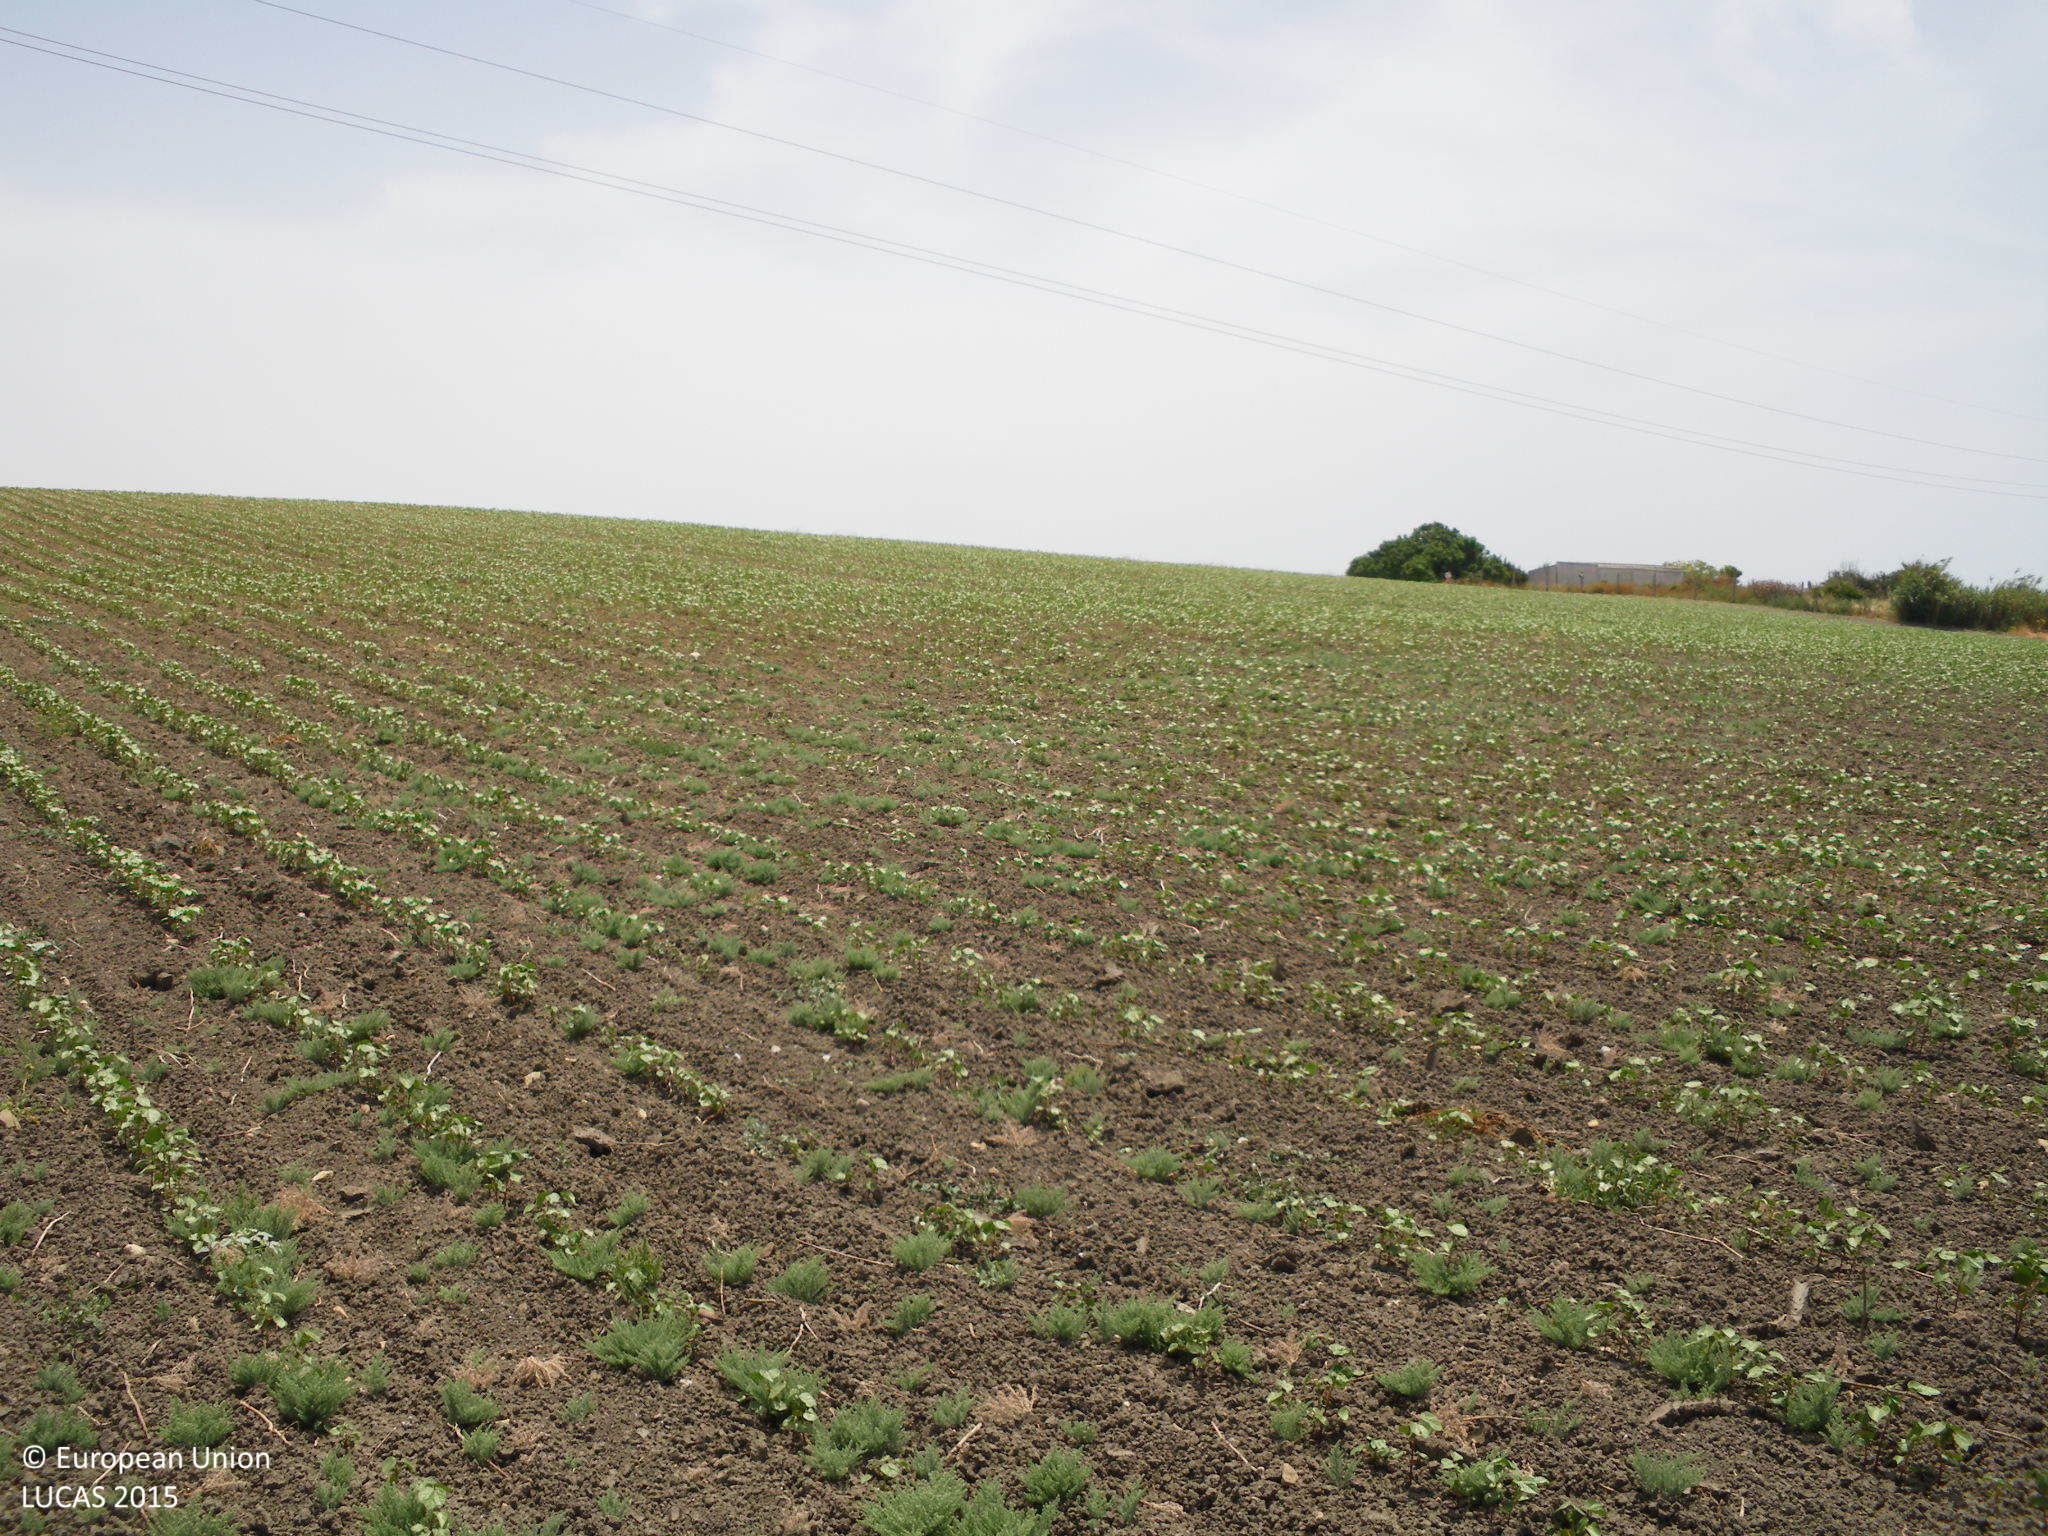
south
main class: Cropland
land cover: Cotton
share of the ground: 10 - 25 %
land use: Agriculture (excluding fallow land and kitchen gardens)
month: June
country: ES
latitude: 36.7060
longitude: -6.3710
